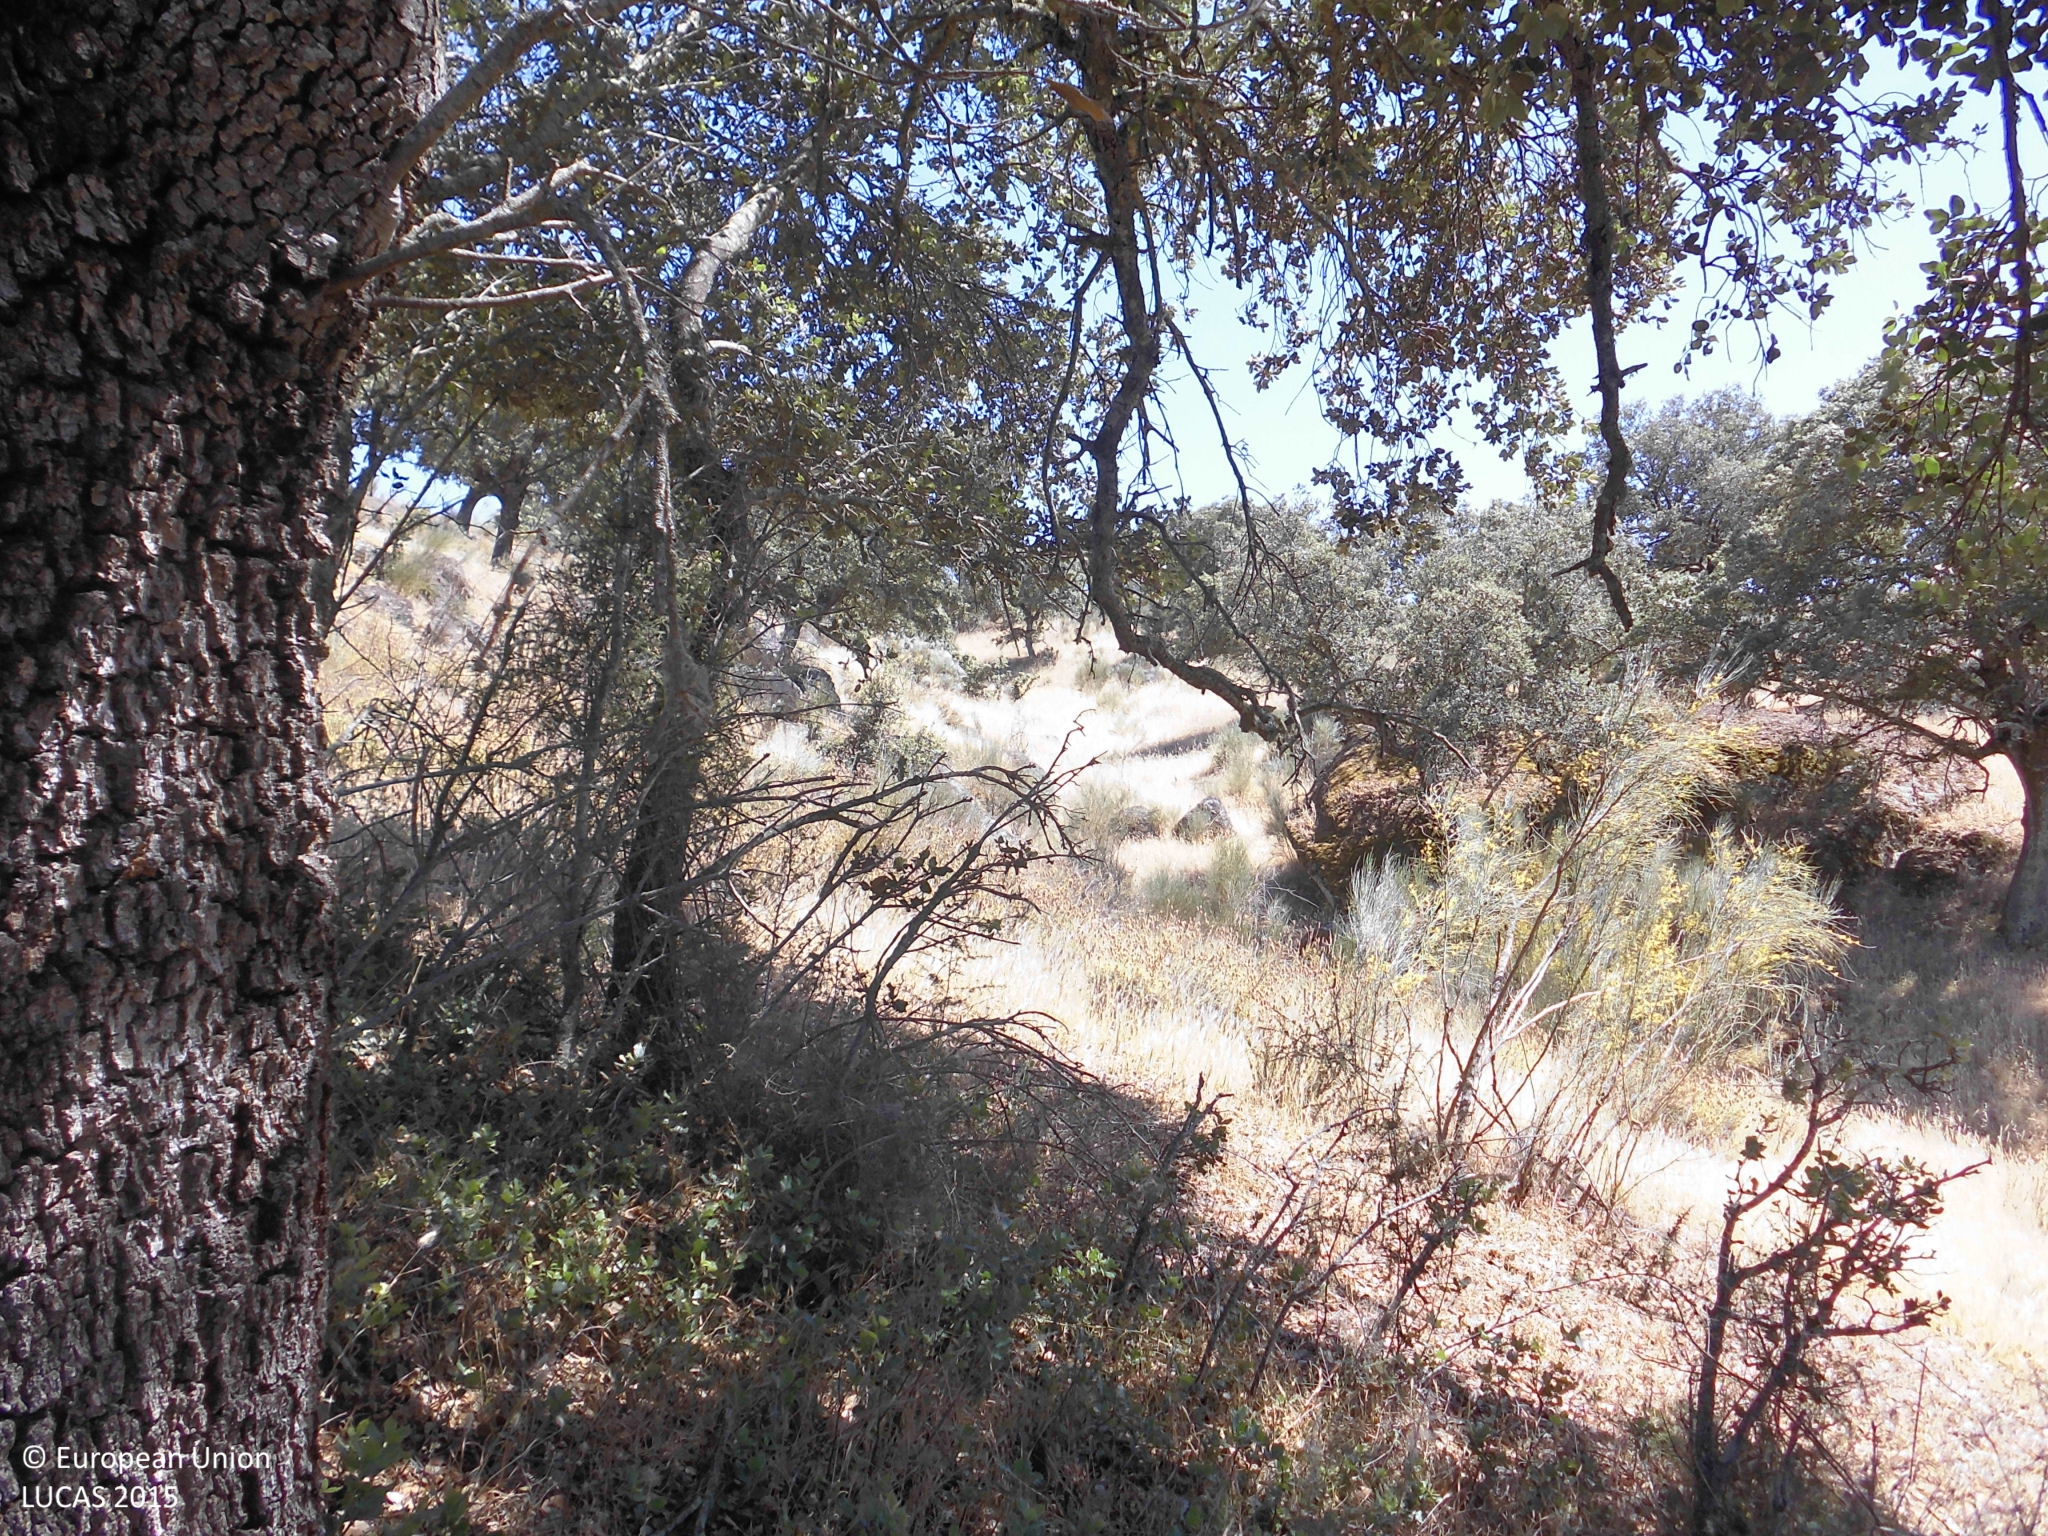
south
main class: Woodland
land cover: Broadleaved woodland
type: broadleaved evergreen forest
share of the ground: 25 - 50 %
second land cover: Grassland without tree/shrub cover
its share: > 75 %
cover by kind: herbaceous plants 65 %, broadleaved forest trees 25 %, shrubs 10 %
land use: Forestry
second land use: Agriculture (excluding fallow land and kitchen gardens)
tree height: > 5 m
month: May
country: ES
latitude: 39.5505
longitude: -6.6584
